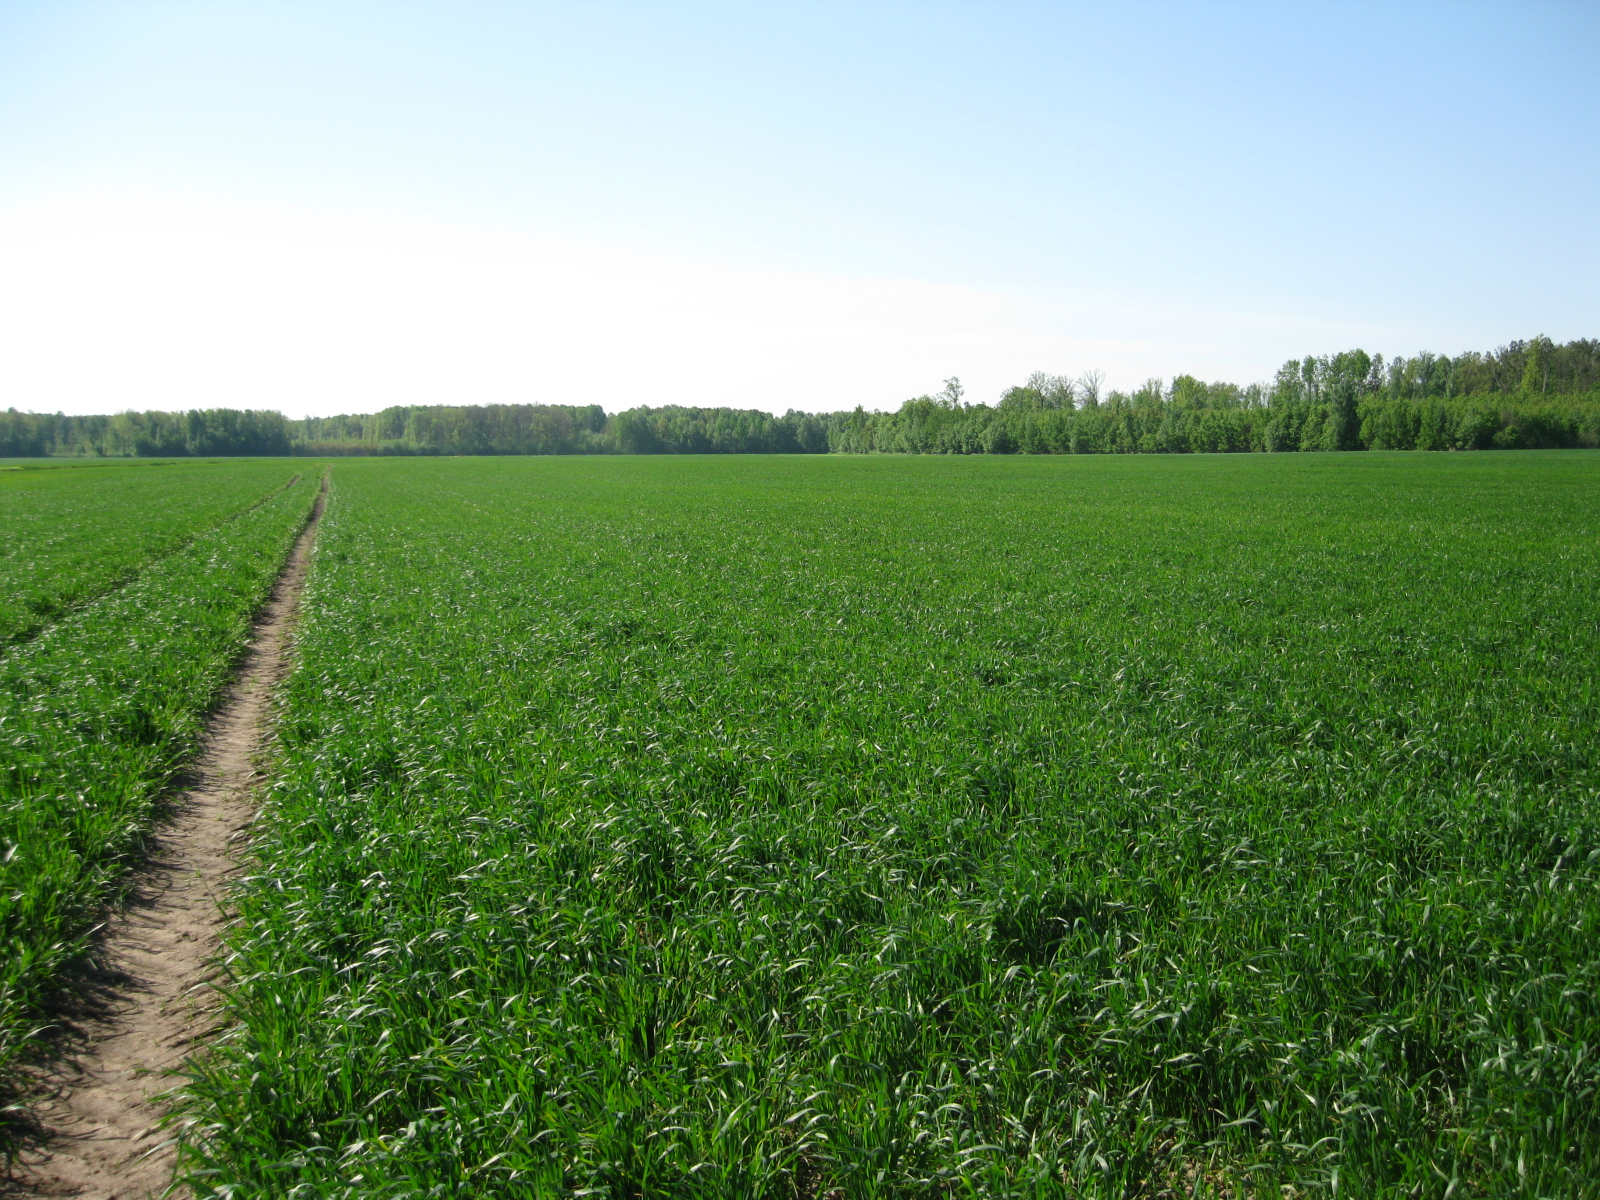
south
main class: Cropland
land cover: Common wheat
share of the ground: > 75 %
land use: Agriculture (excluding fallow land and kitchen gardens)
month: May
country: LT
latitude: 56.1066
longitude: 24.1923
